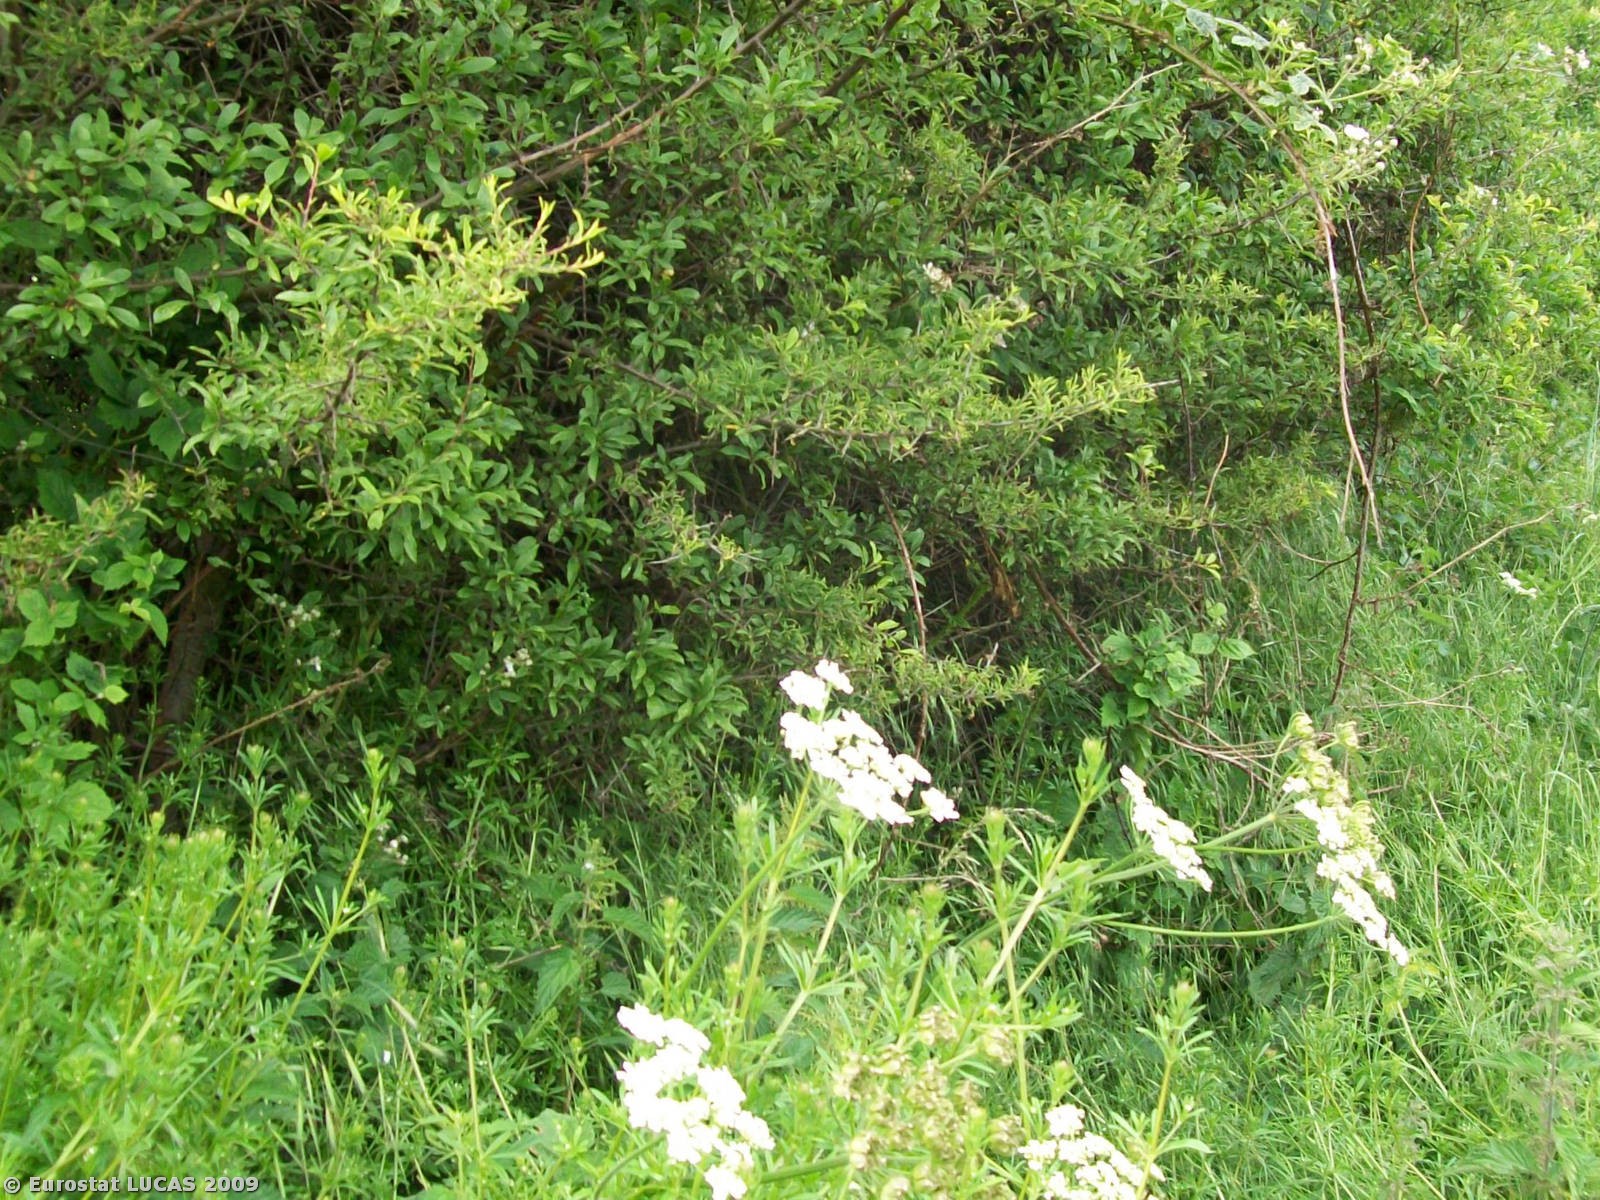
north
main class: Cropland
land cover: Common wheat
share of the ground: > 75 %
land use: Agriculture (excluding fallow land and kitchen gardens)
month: June
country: GB
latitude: 53.1228
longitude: -0.9364
